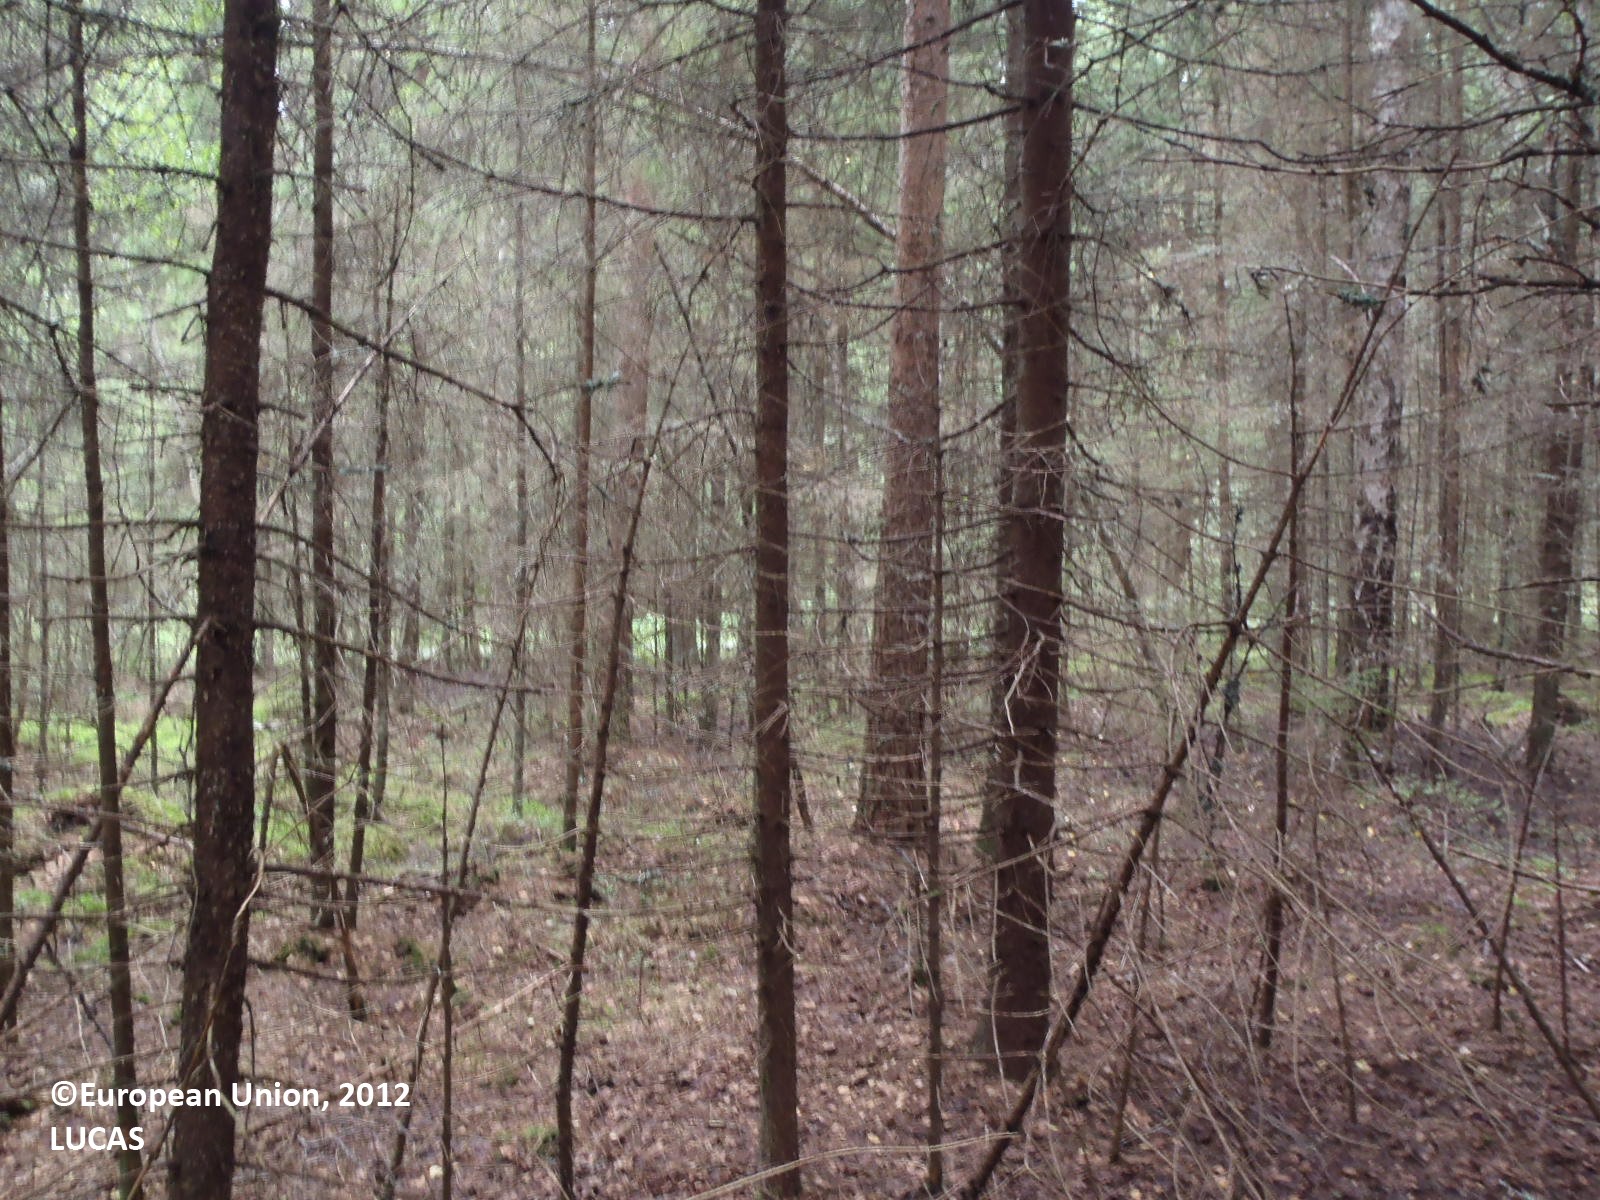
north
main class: Woodland
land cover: Spruce dominated coniferous woodland
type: boreal forest
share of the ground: > 75 %
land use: Forestry
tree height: > 5 m
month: August
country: FI
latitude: 60.7545
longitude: 21.8584
